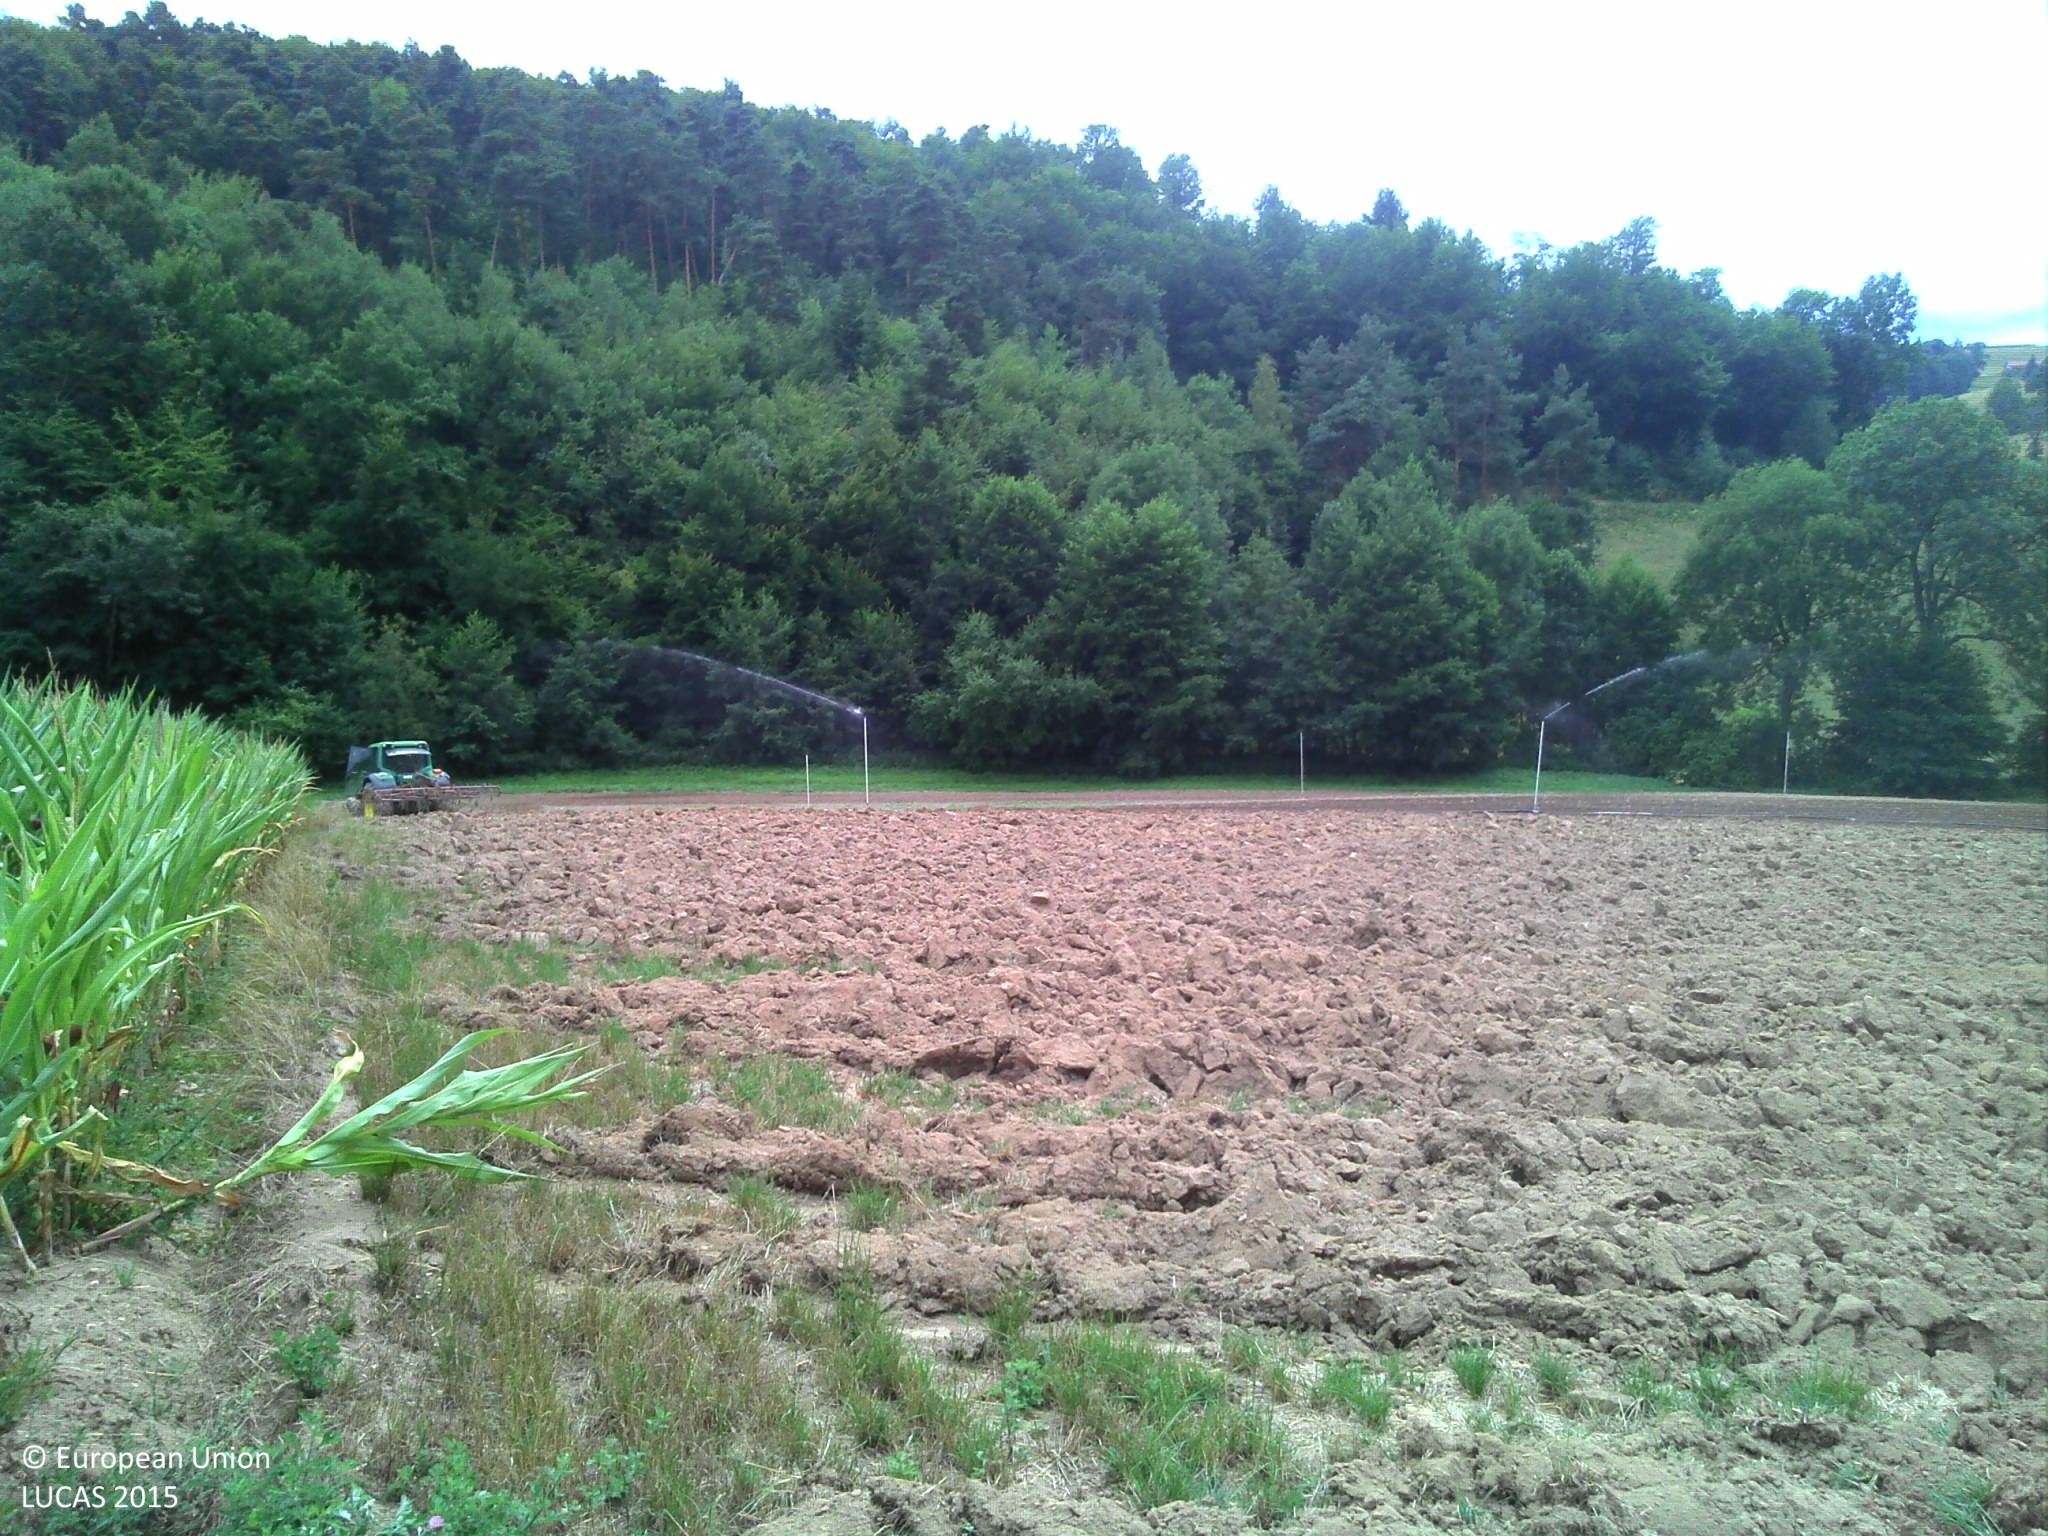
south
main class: Cropland
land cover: Maize
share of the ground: > 75 %
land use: Agriculture (excluding fallow land and kitchen gardens)
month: July
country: FR
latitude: 45.5947
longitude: 4.4785
